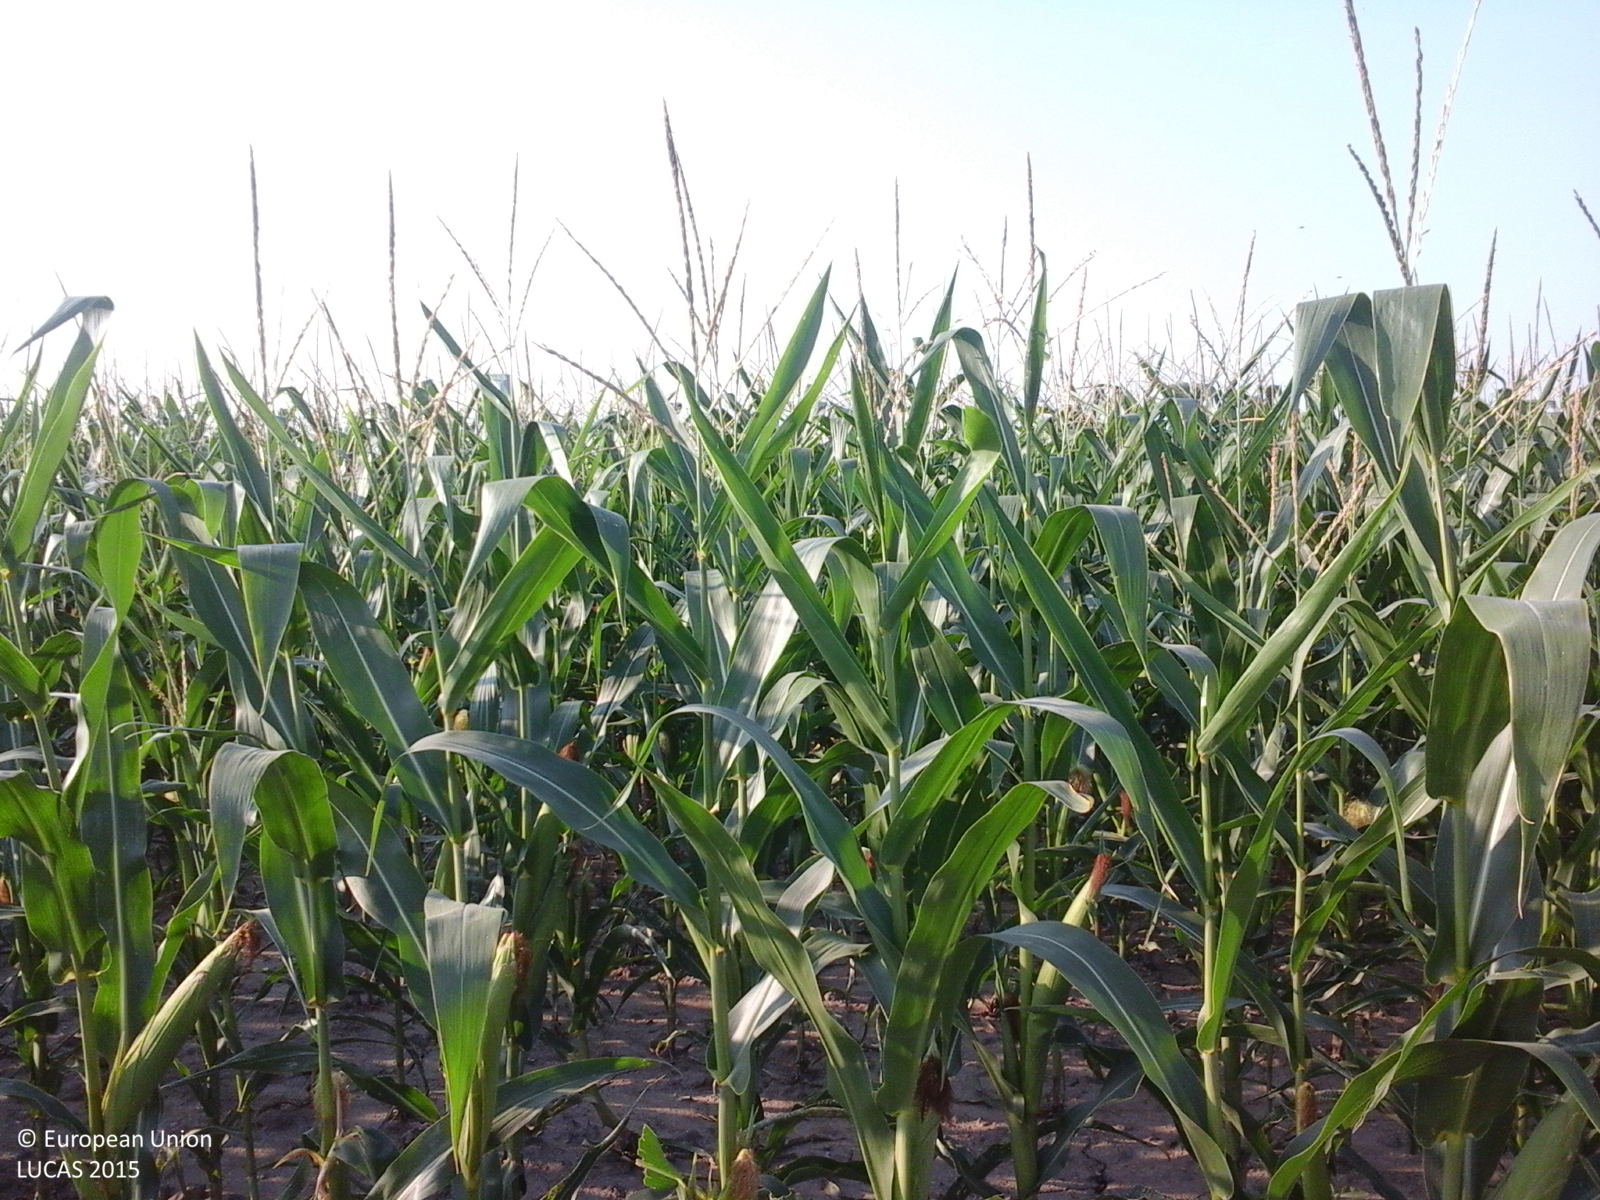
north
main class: Cropland
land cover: Maize
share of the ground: > 75 %
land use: Agriculture (excluding fallow land and kitchen gardens)
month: July
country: RO
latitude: 44.7770
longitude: 27.2102
